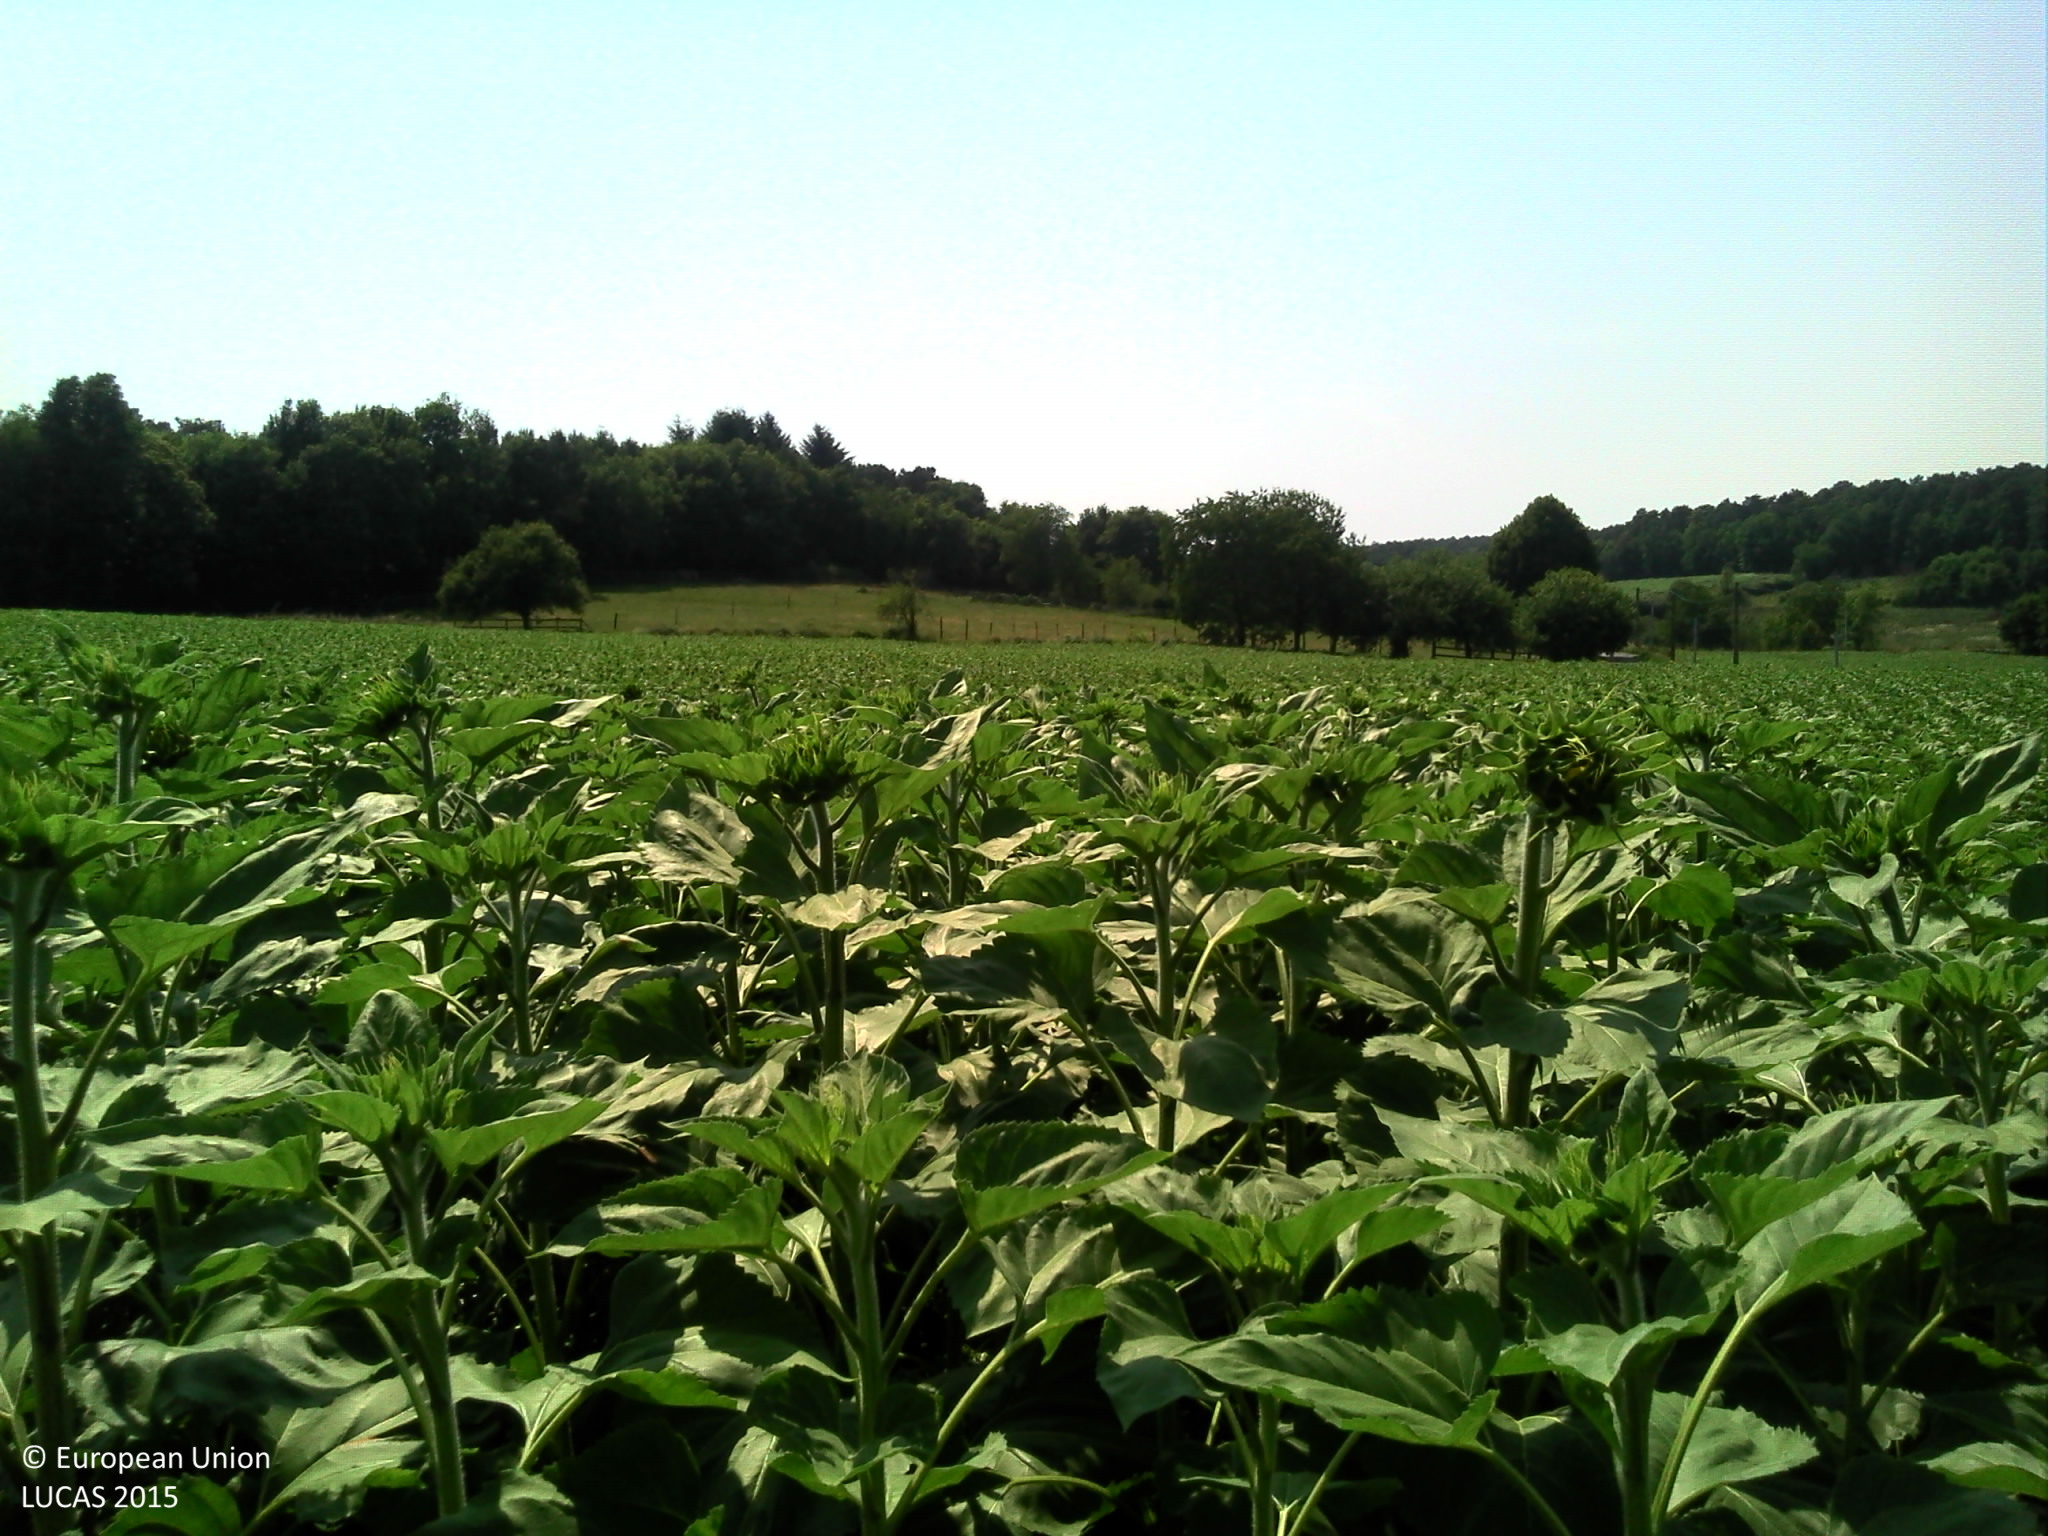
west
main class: Cropland
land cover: Sunflower
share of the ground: > 75 %
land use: Agriculture (excluding fallow land and kitchen gardens)
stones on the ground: < 10 %
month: July
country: FR
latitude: 46.8496
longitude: 0.4729
